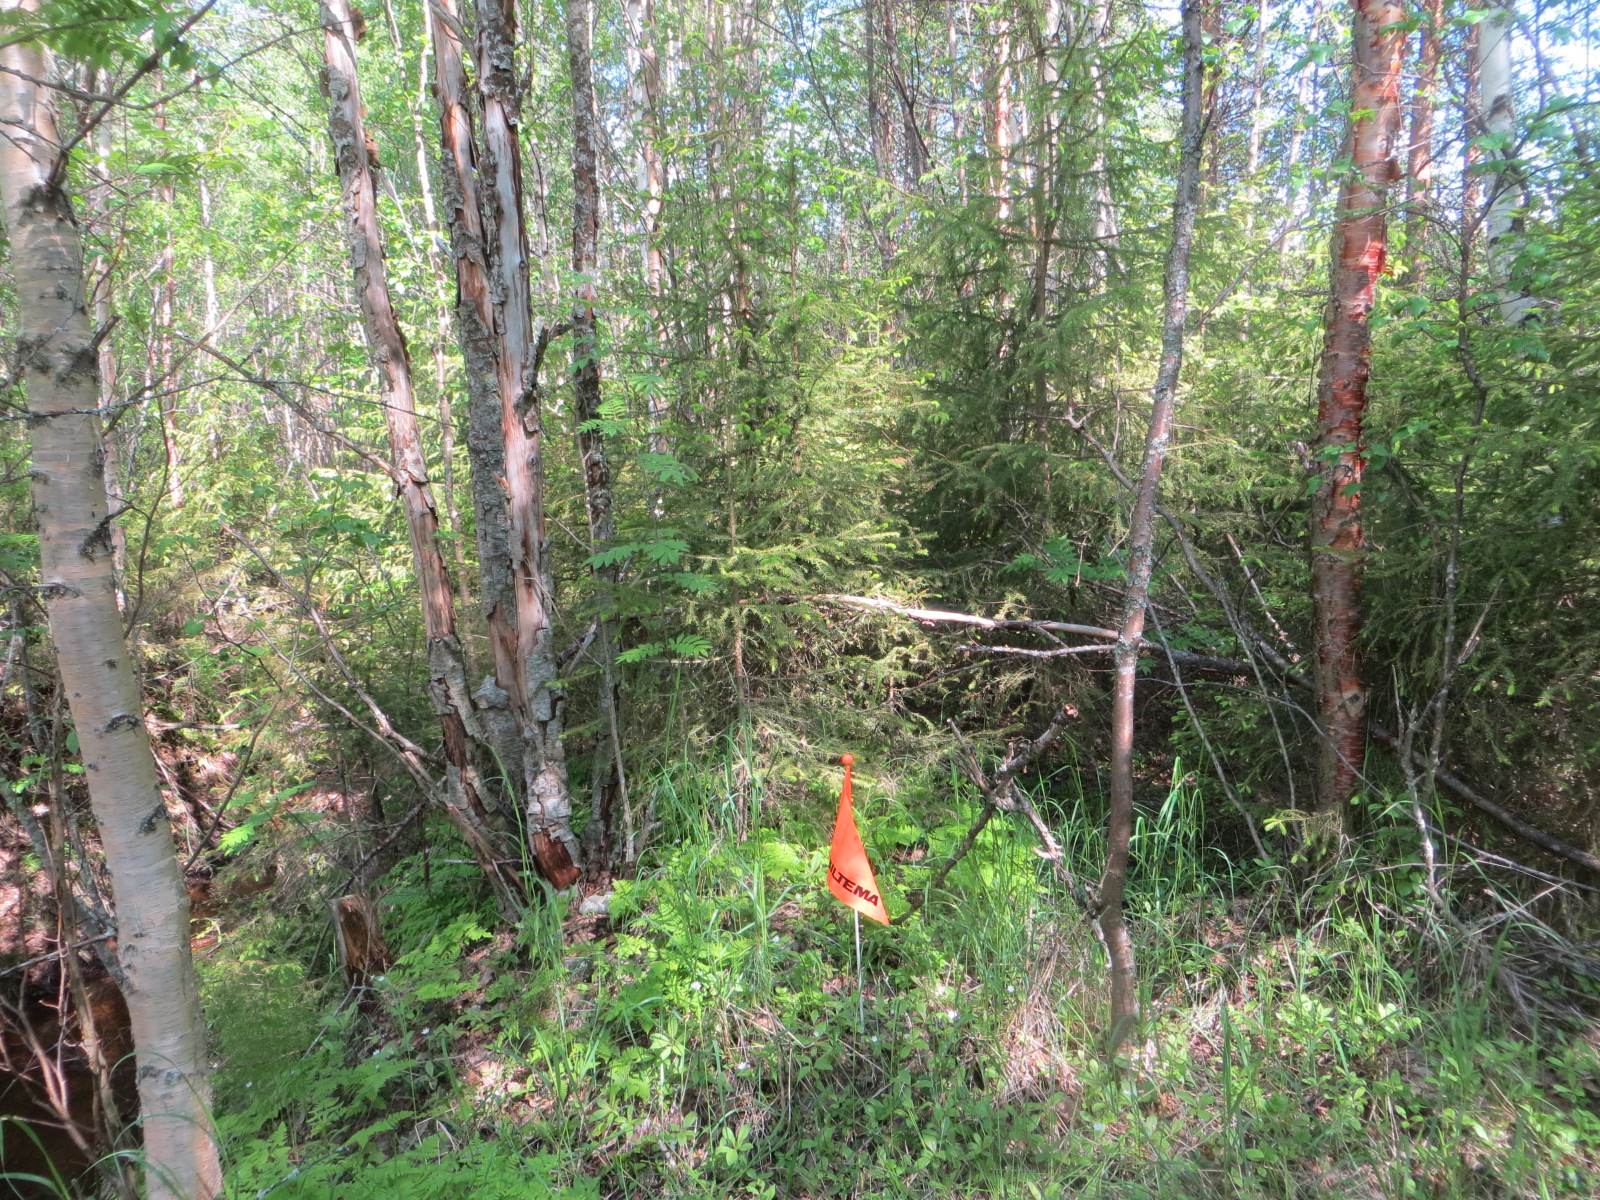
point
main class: Woodland
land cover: Other mixed woodland
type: boreal forest
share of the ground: > 75 %
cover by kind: broadleaved forest trees 45 %, coniferous forest trees 40 %, herbaceous plants 15 %
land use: Forestry
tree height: > 5 m
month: June
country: FI
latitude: 66.5043
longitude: 25.6441
